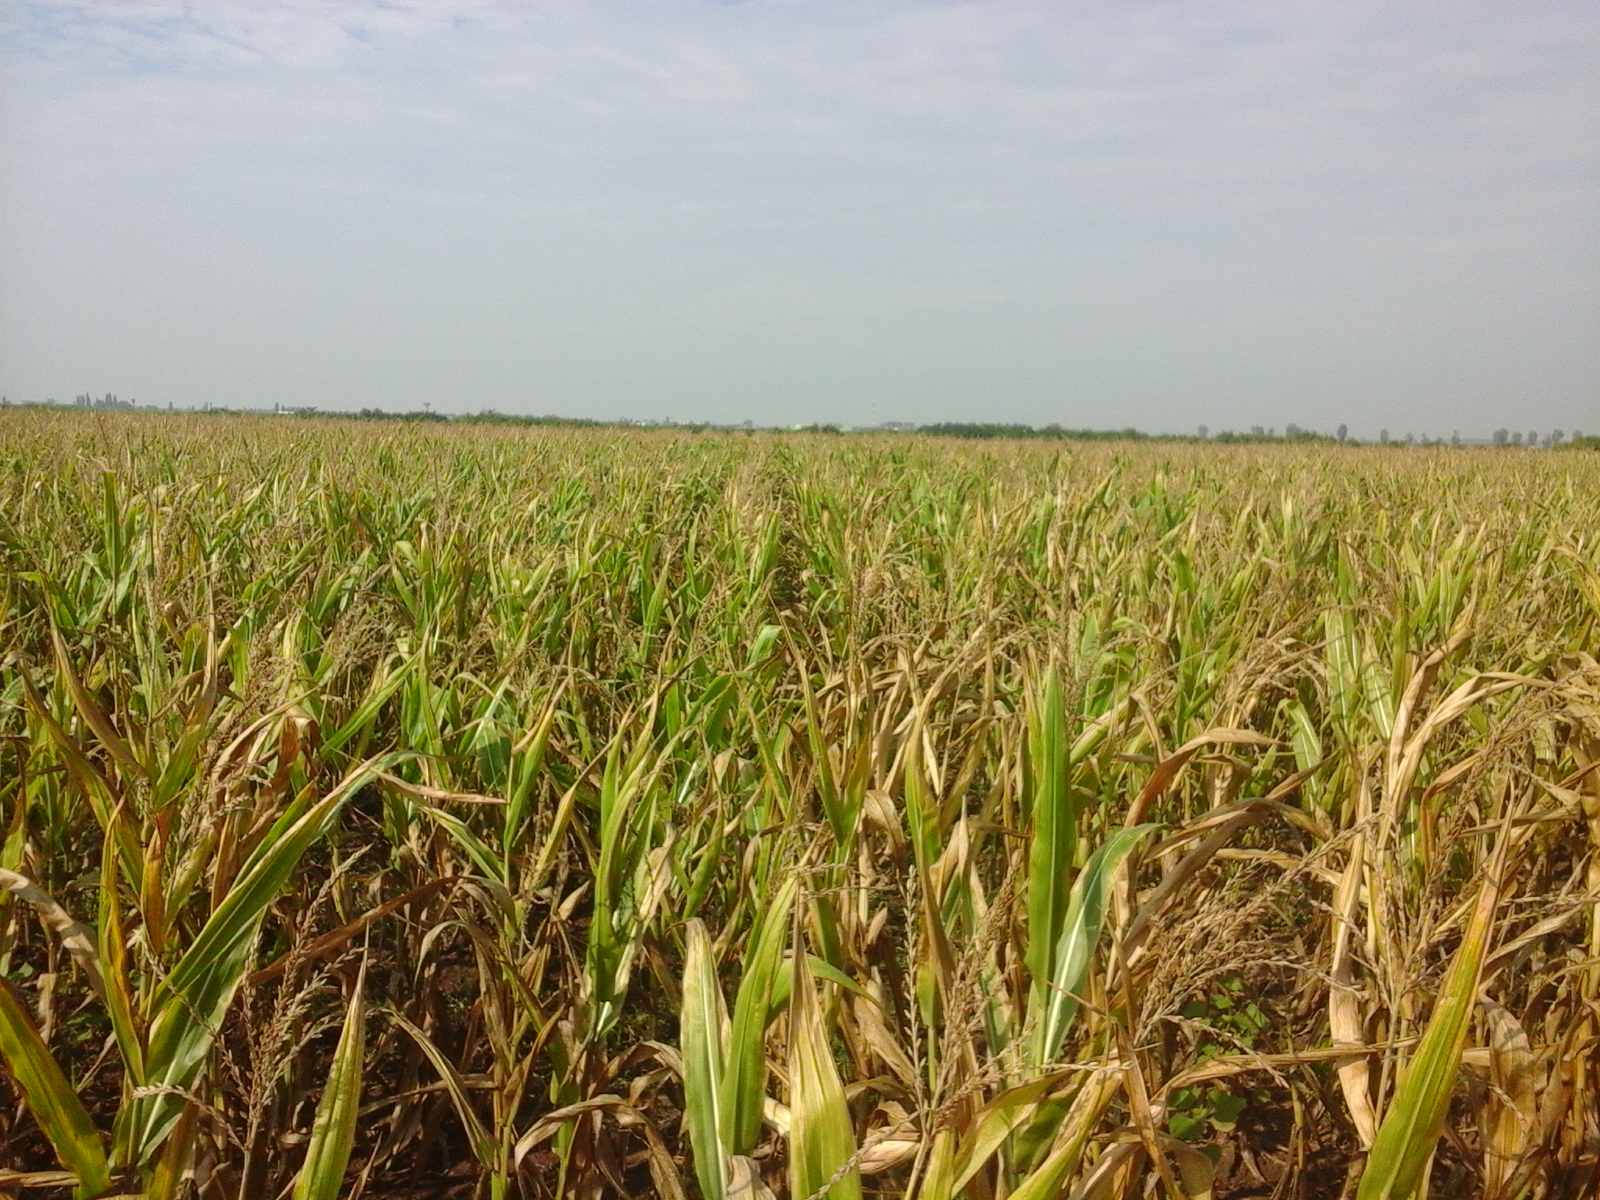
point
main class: Cropland
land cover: Maize
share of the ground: > 75 %
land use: Agriculture (excluding fallow land and kitchen gardens)
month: August
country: RO
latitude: 46.5413
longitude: 21.5531
